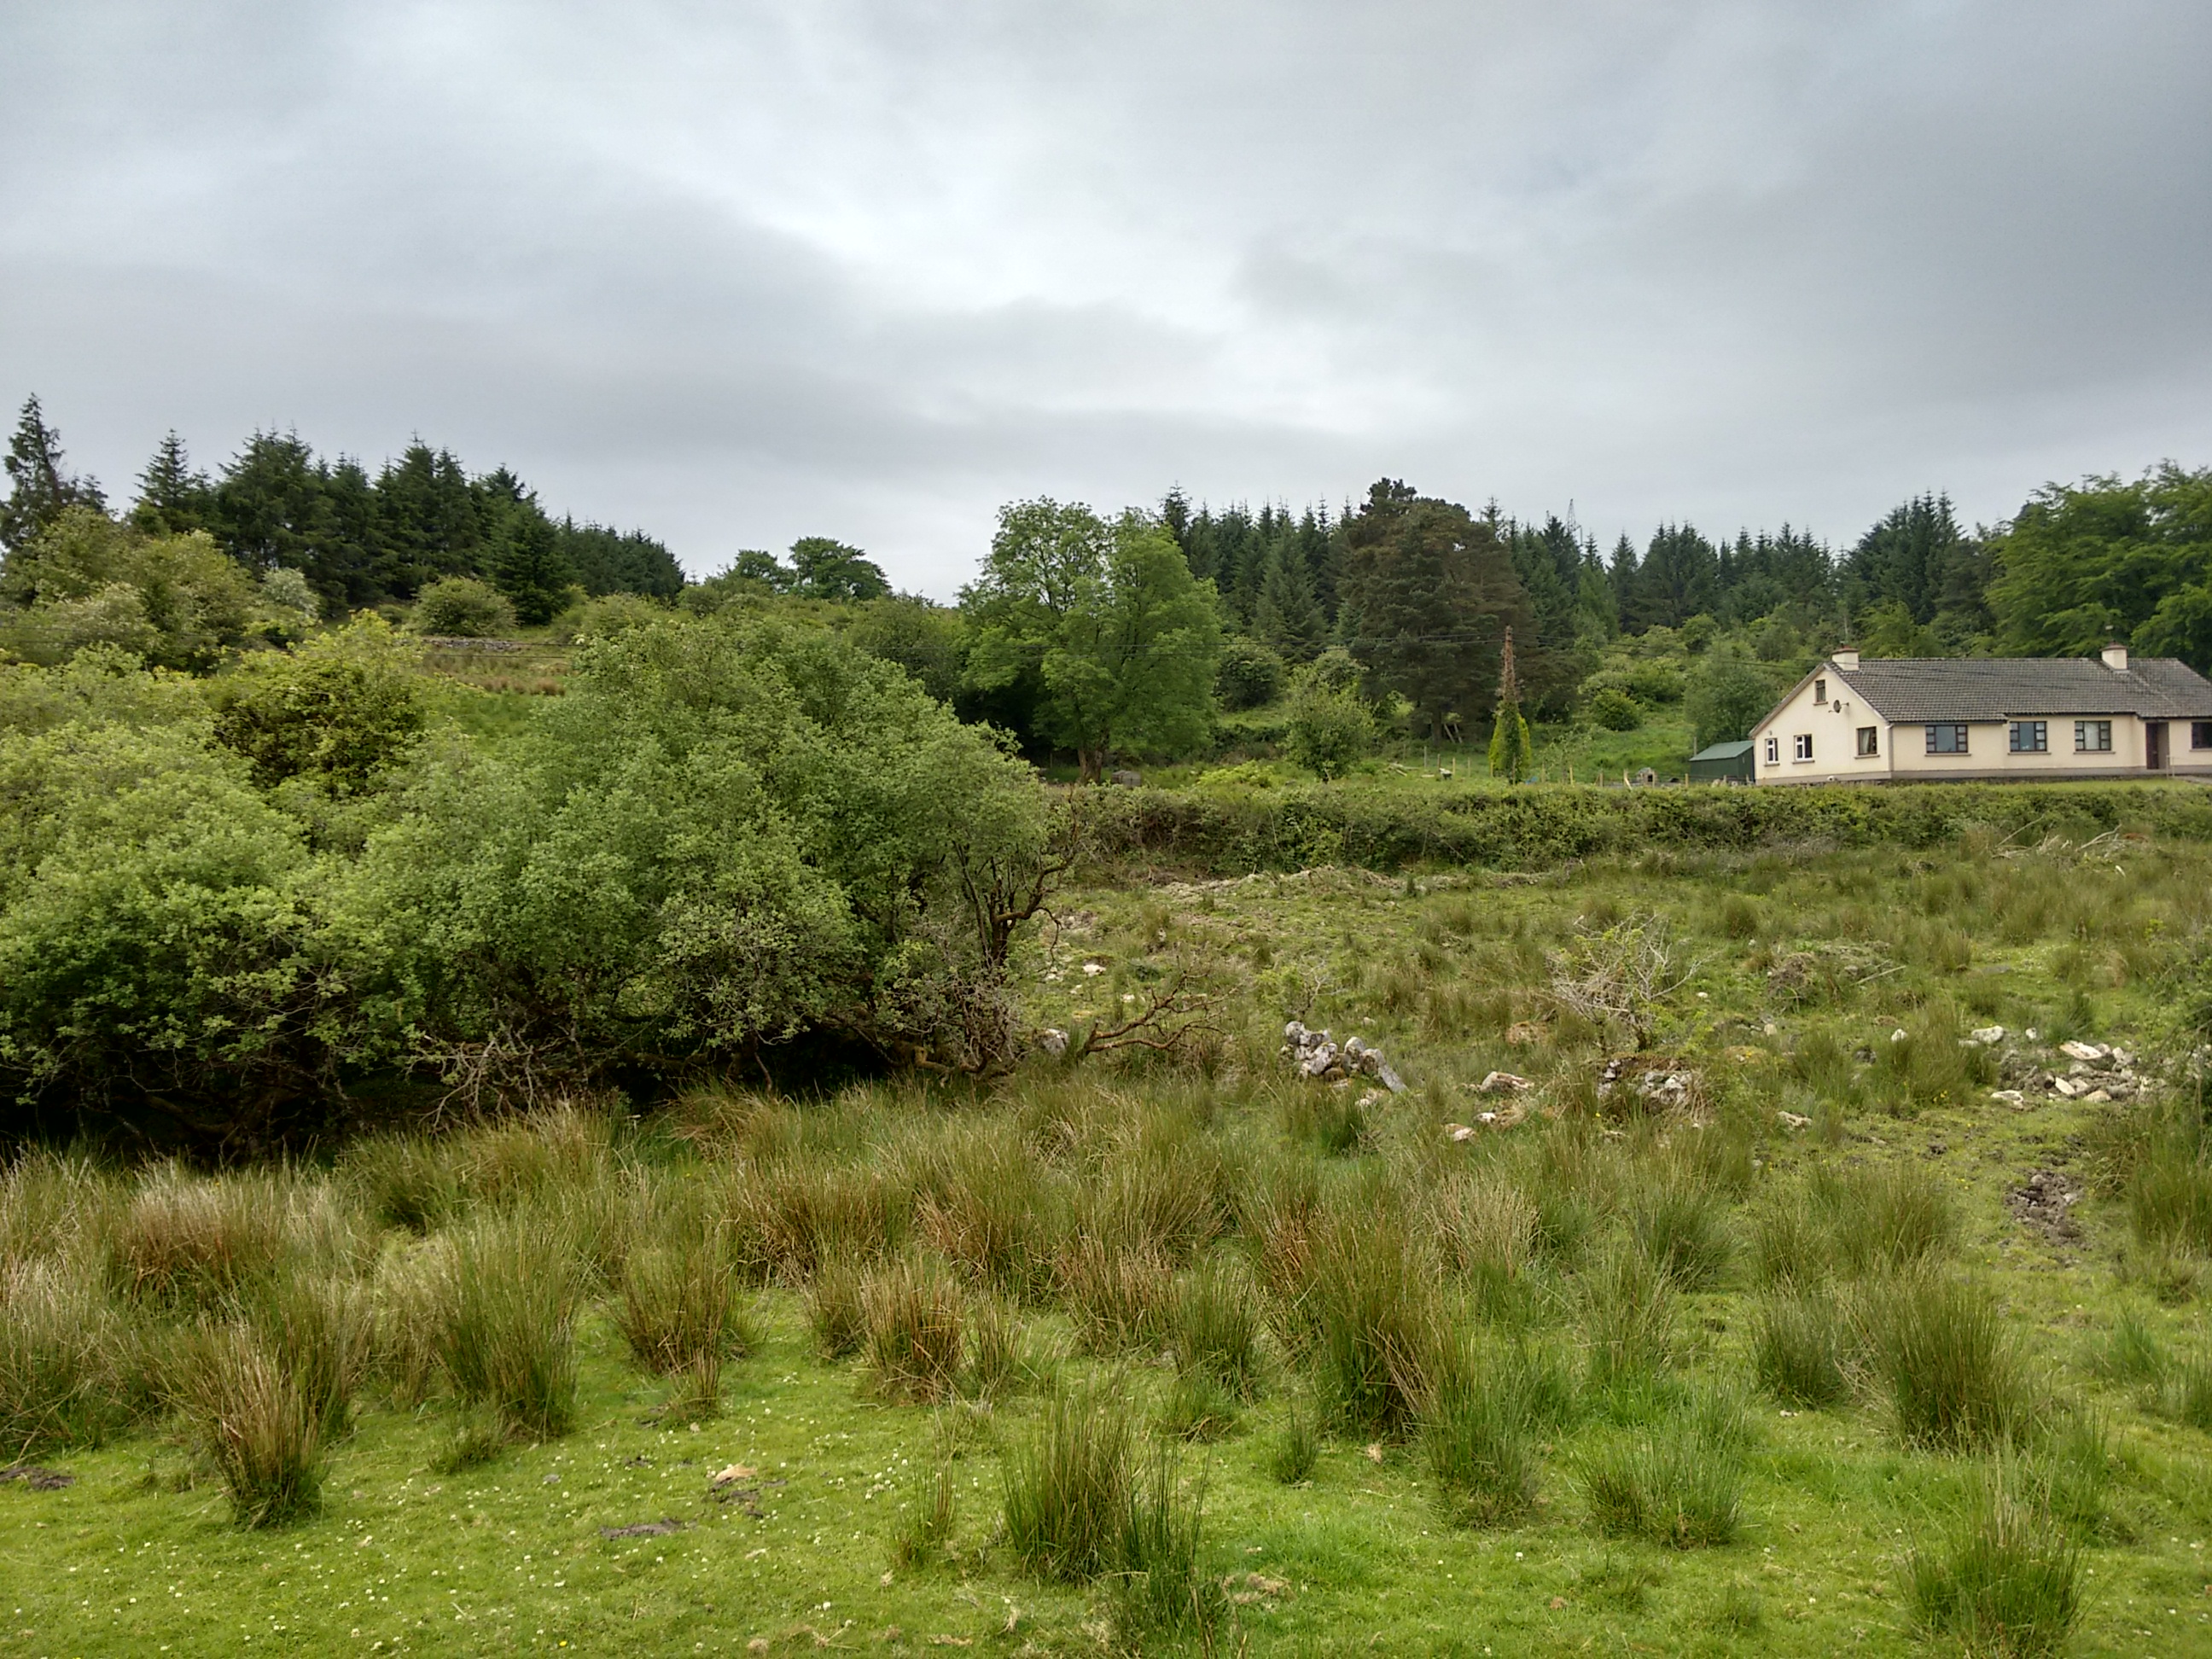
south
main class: Grassland
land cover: Grassland with sparse tree/shrub cover
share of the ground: > 75 %
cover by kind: herbaceous plants 85 %, shrubs 10 %, broadleaved forest trees 5 %
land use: Agriculture (excluding fallow land and kitchen gardens)
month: June
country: IE
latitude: 53.0701
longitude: -8.4757
